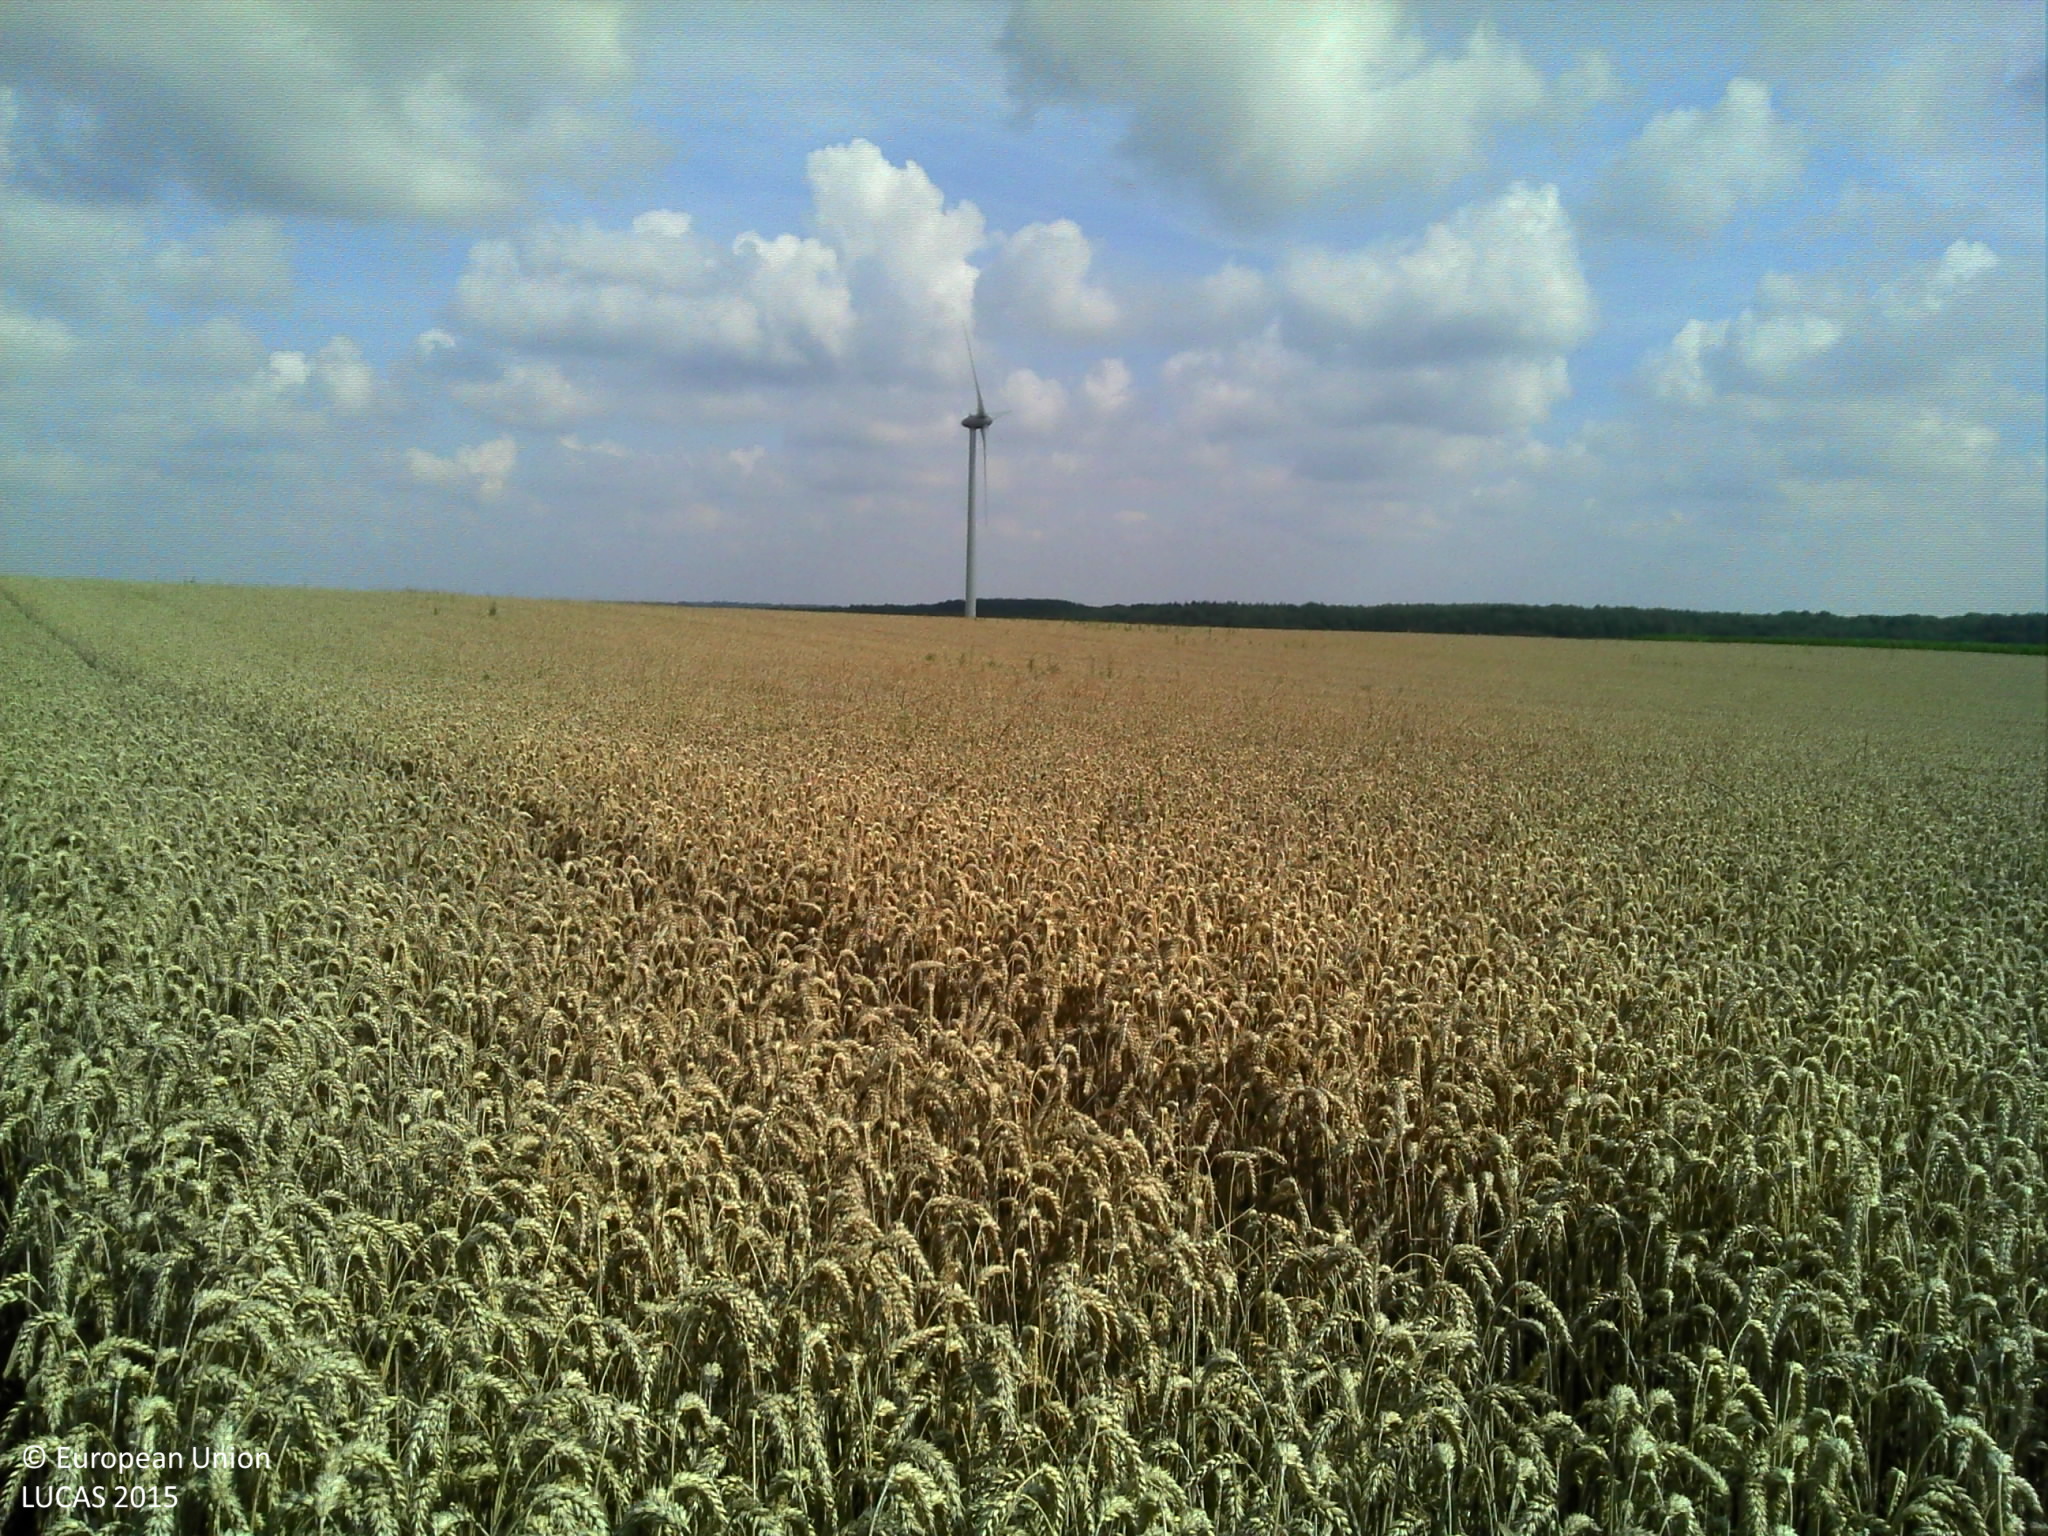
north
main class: Cropland
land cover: Common wheat
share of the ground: > 75 %
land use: Agriculture (excluding fallow land and kitchen gardens)
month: July
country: FR
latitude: 50.1001
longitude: 2.5081
